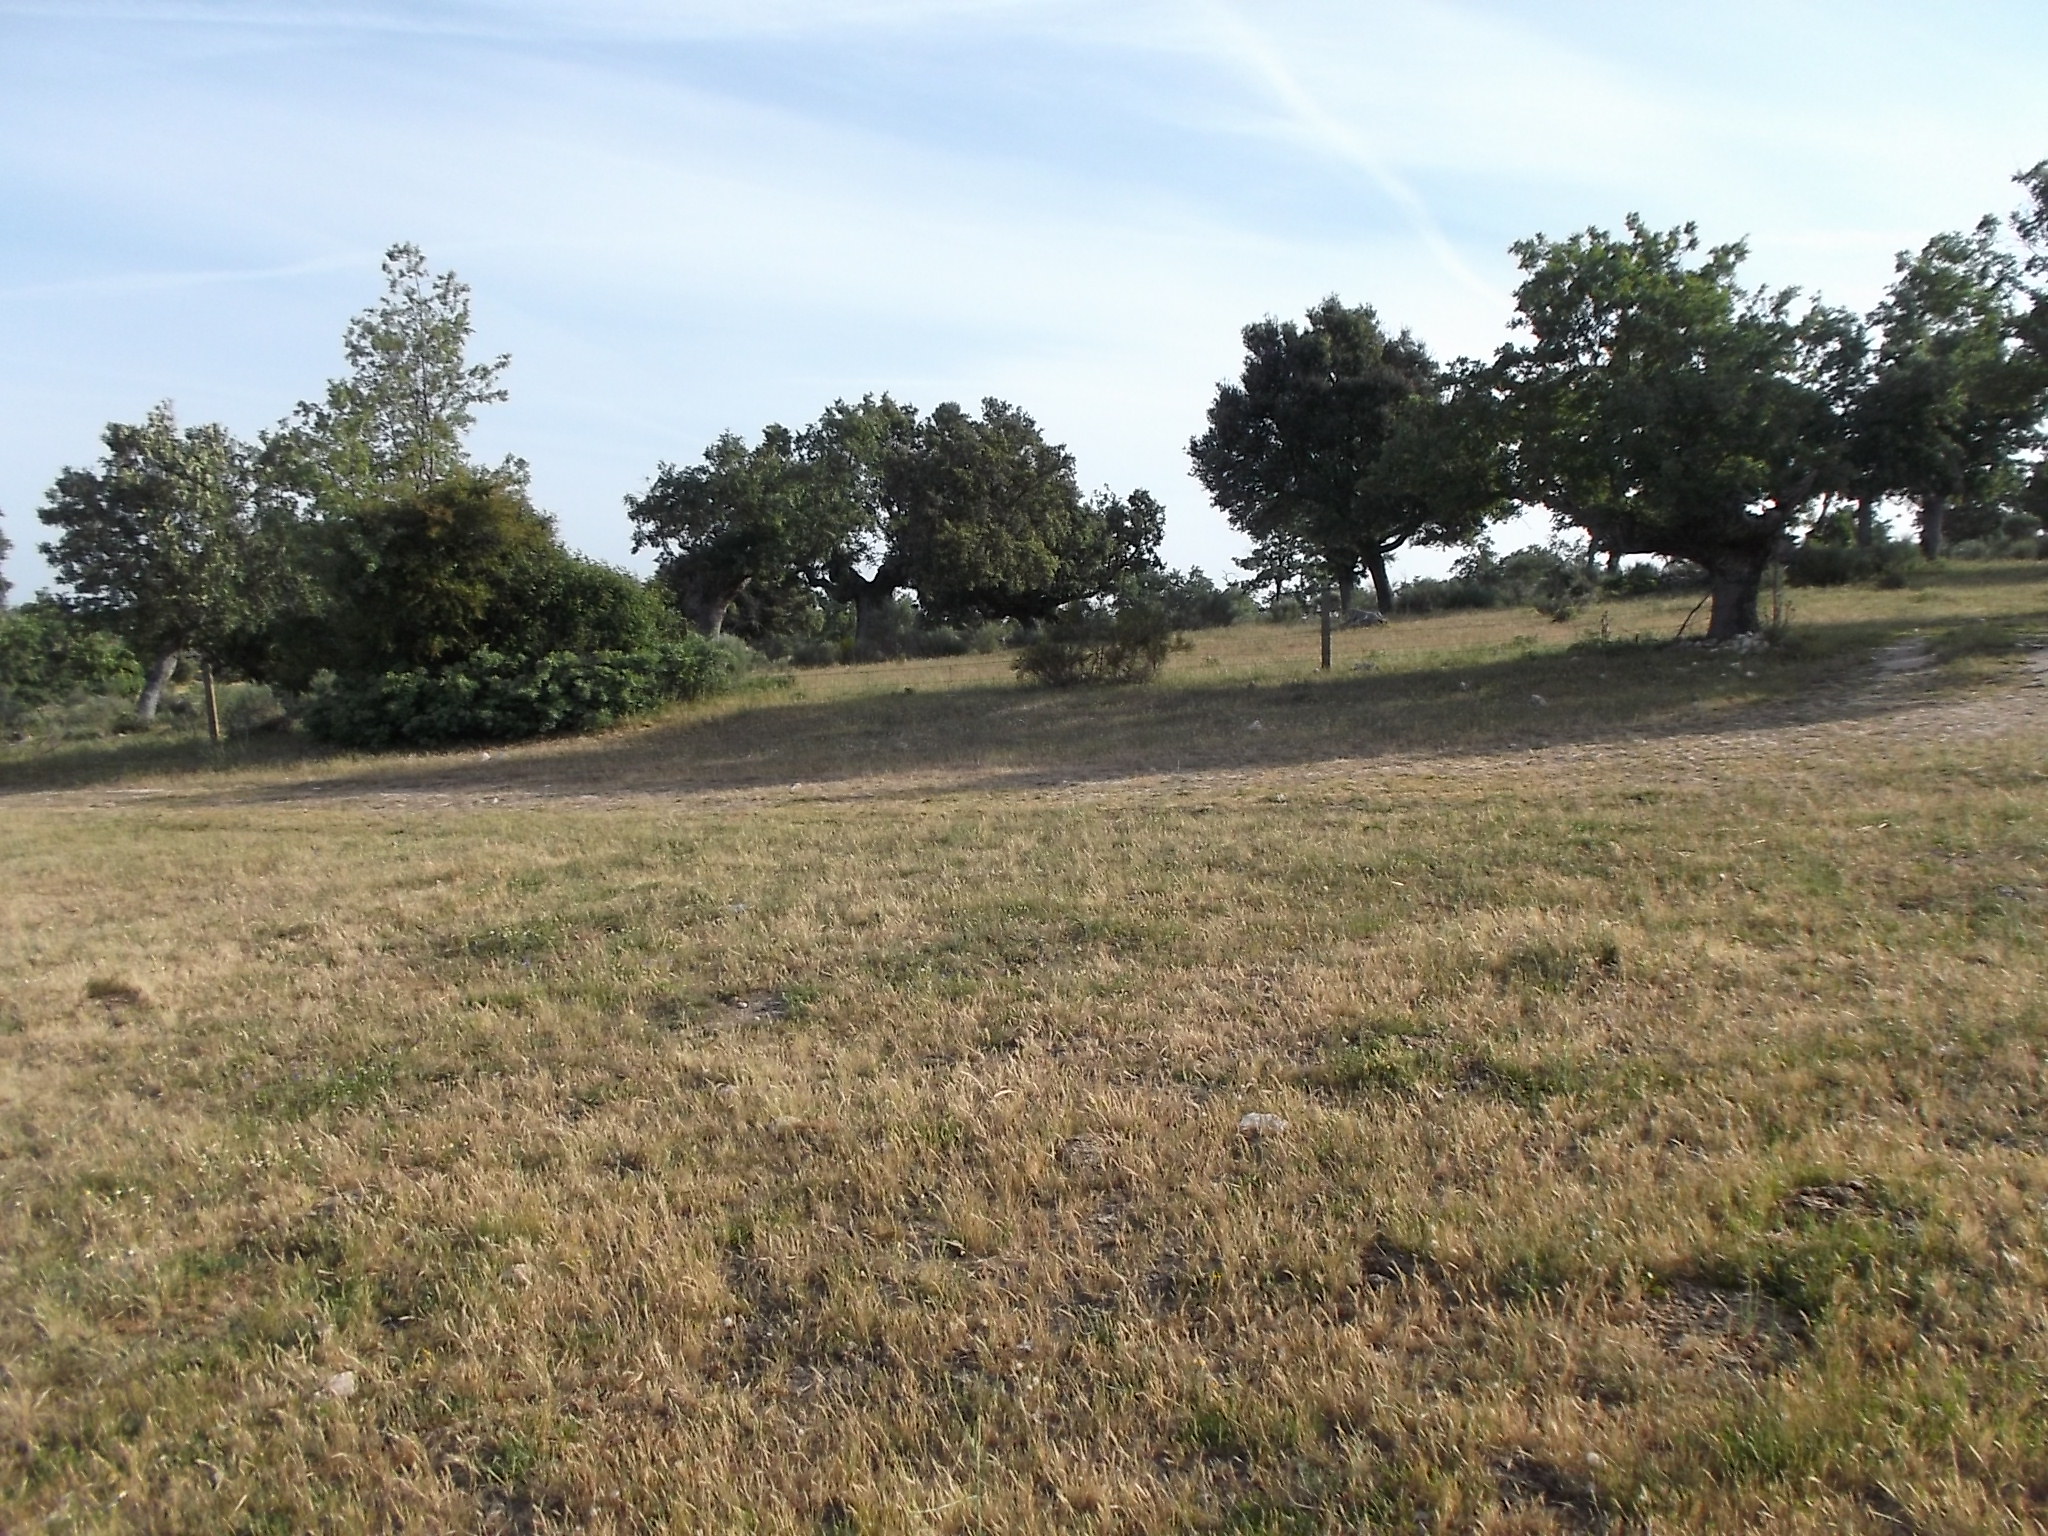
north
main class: Grassland
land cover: Grassland with sparse tree/shrub cover
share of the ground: > 75 %
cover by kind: herbaceous plants 90 %, broadleaved forest trees 5 %, shrubs 5 %
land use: Agriculture (excluding fallow land and kitchen gardens)
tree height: < 5 m
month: May
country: ES
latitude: 41.0482
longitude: -6.4049
